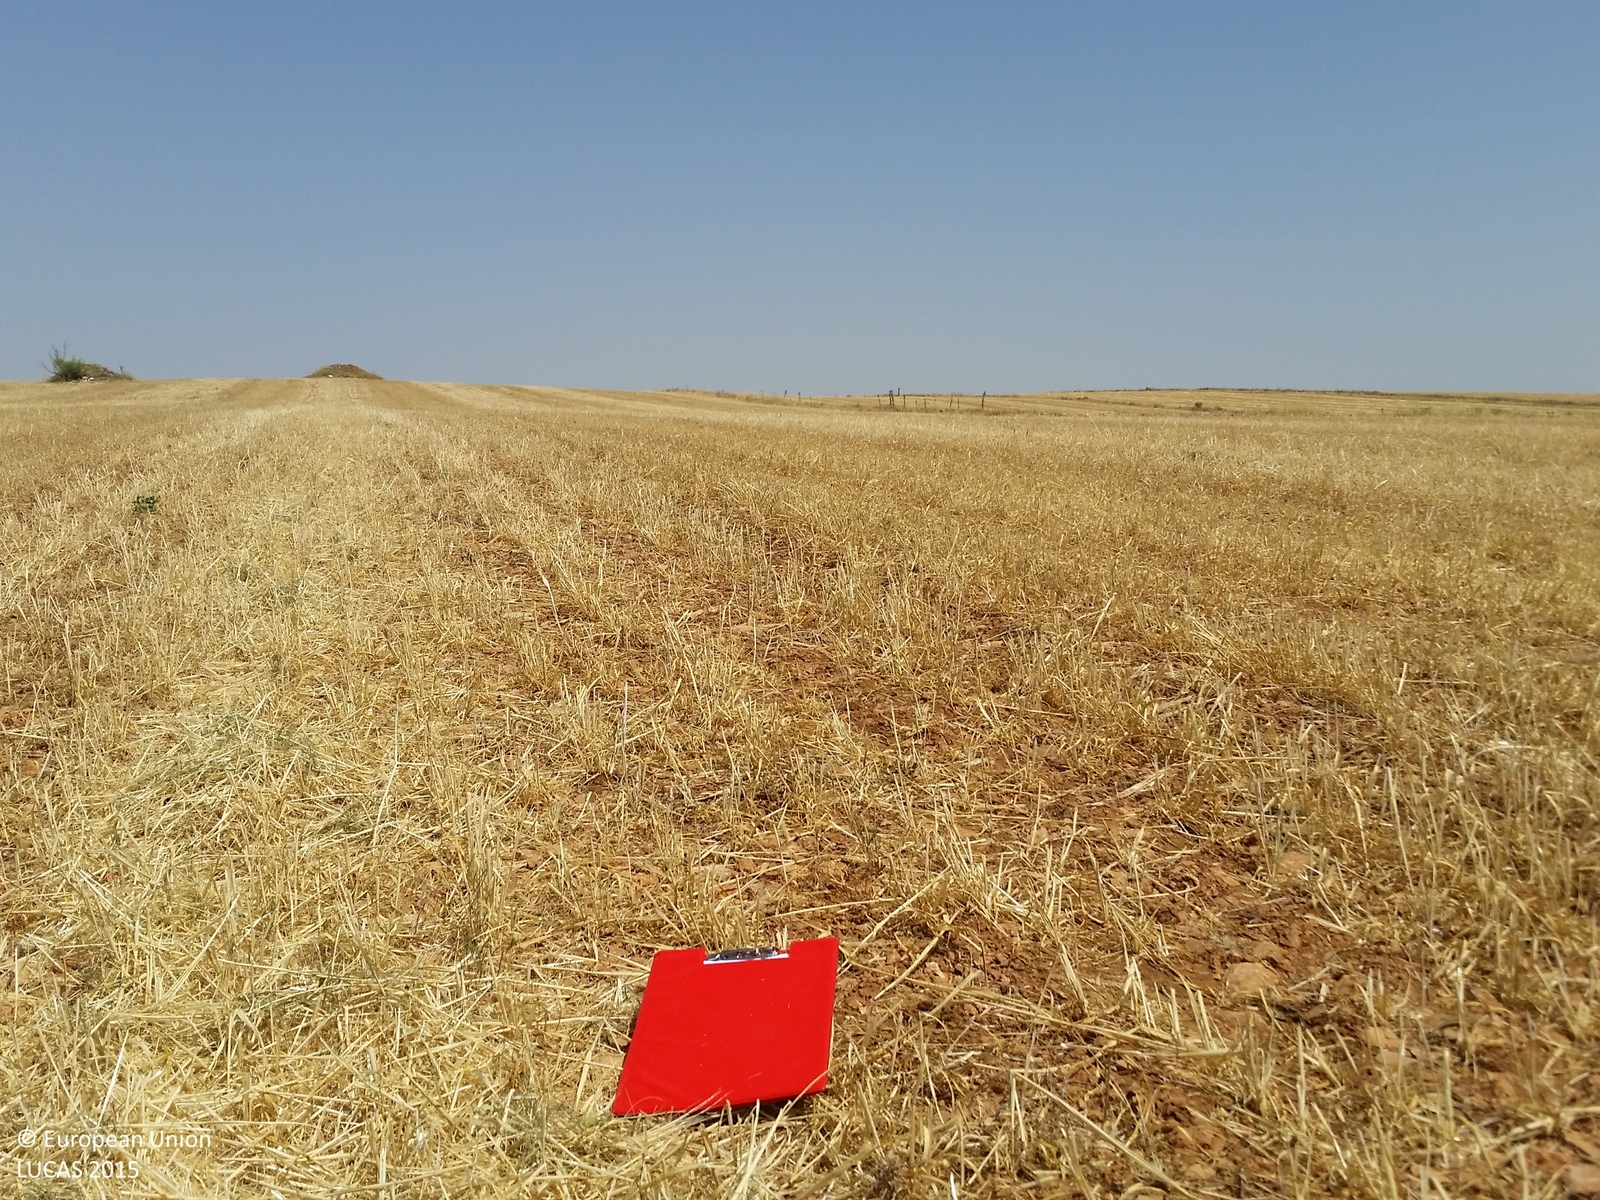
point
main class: Cropland
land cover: Barley
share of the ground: < 10 %
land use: Agriculture (excluding fallow land and kitchen gardens)
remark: Harvested field
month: June
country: ES
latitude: 38.8152
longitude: -2.5686
